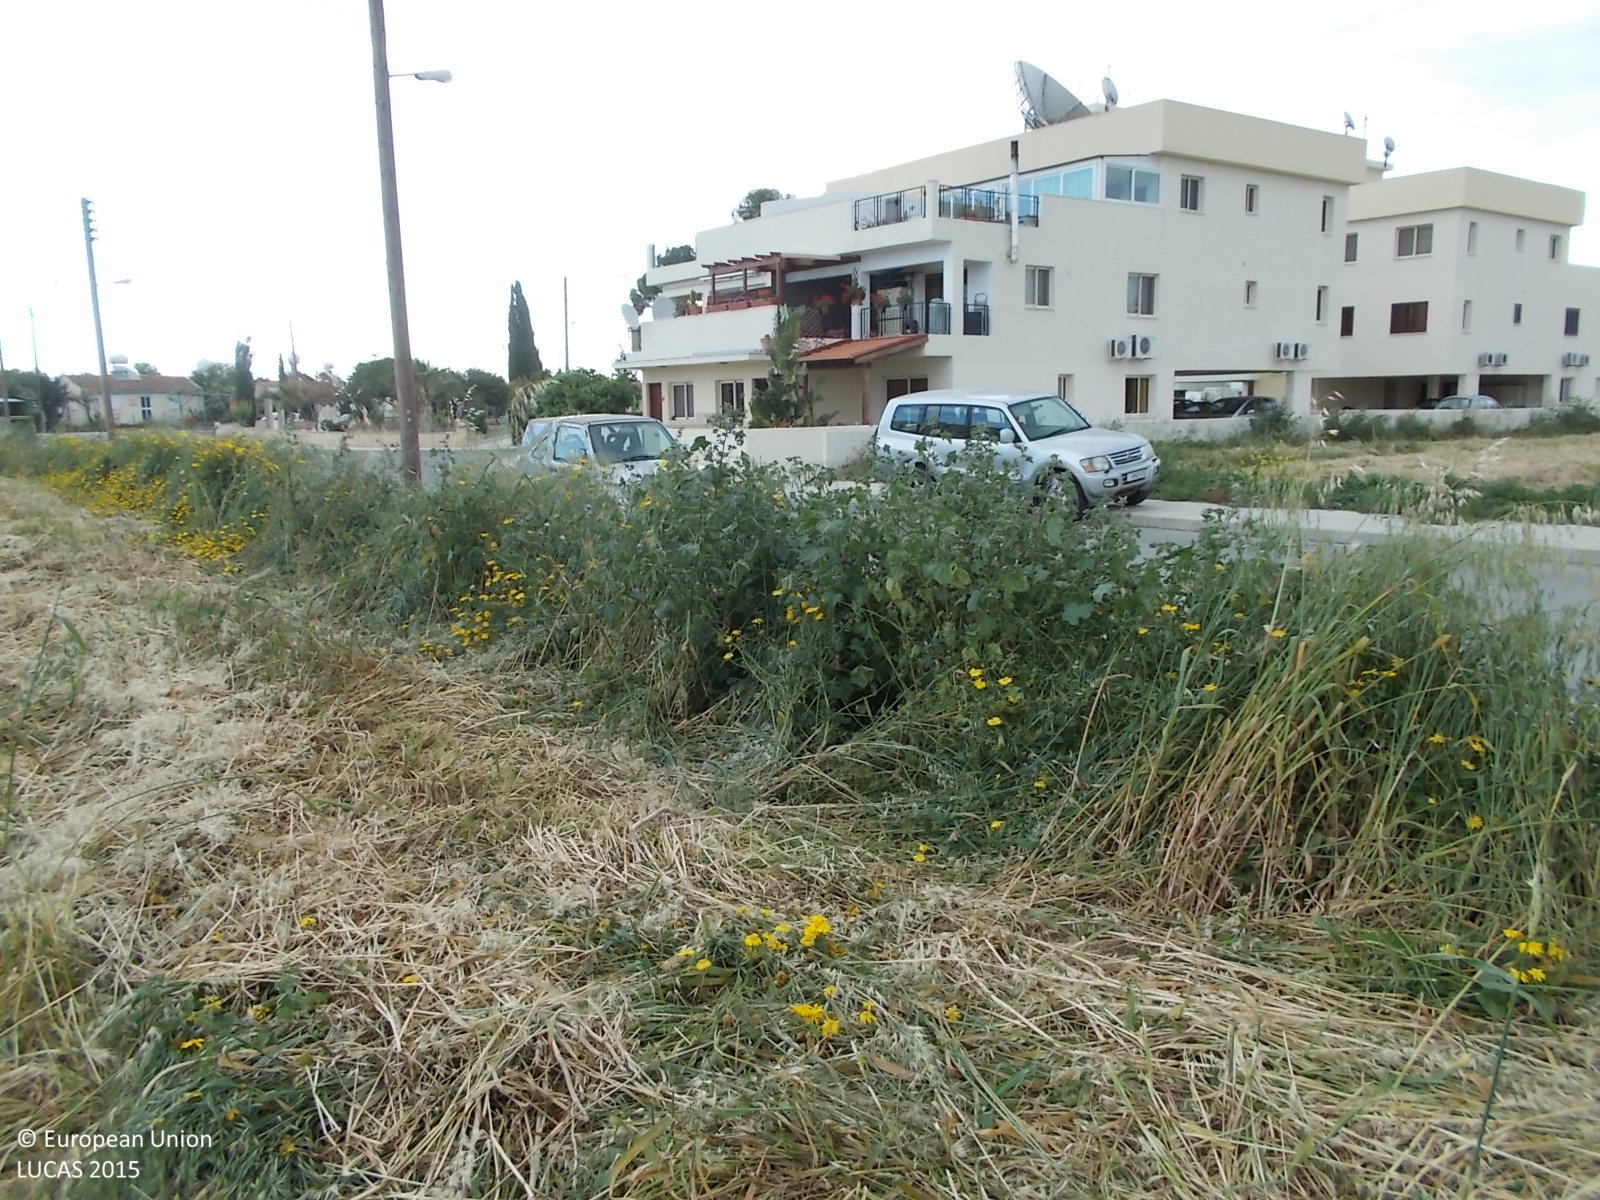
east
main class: Cropland
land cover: Oats
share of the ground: 10 - 25 %
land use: Agriculture (excluding fallow land and kitchen gardens)
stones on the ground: < 10 %
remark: Harvested field
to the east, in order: Oats; Grass margins; Artificial constructions in urban areas
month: April
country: CY
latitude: 34.8314
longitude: 33.5800
